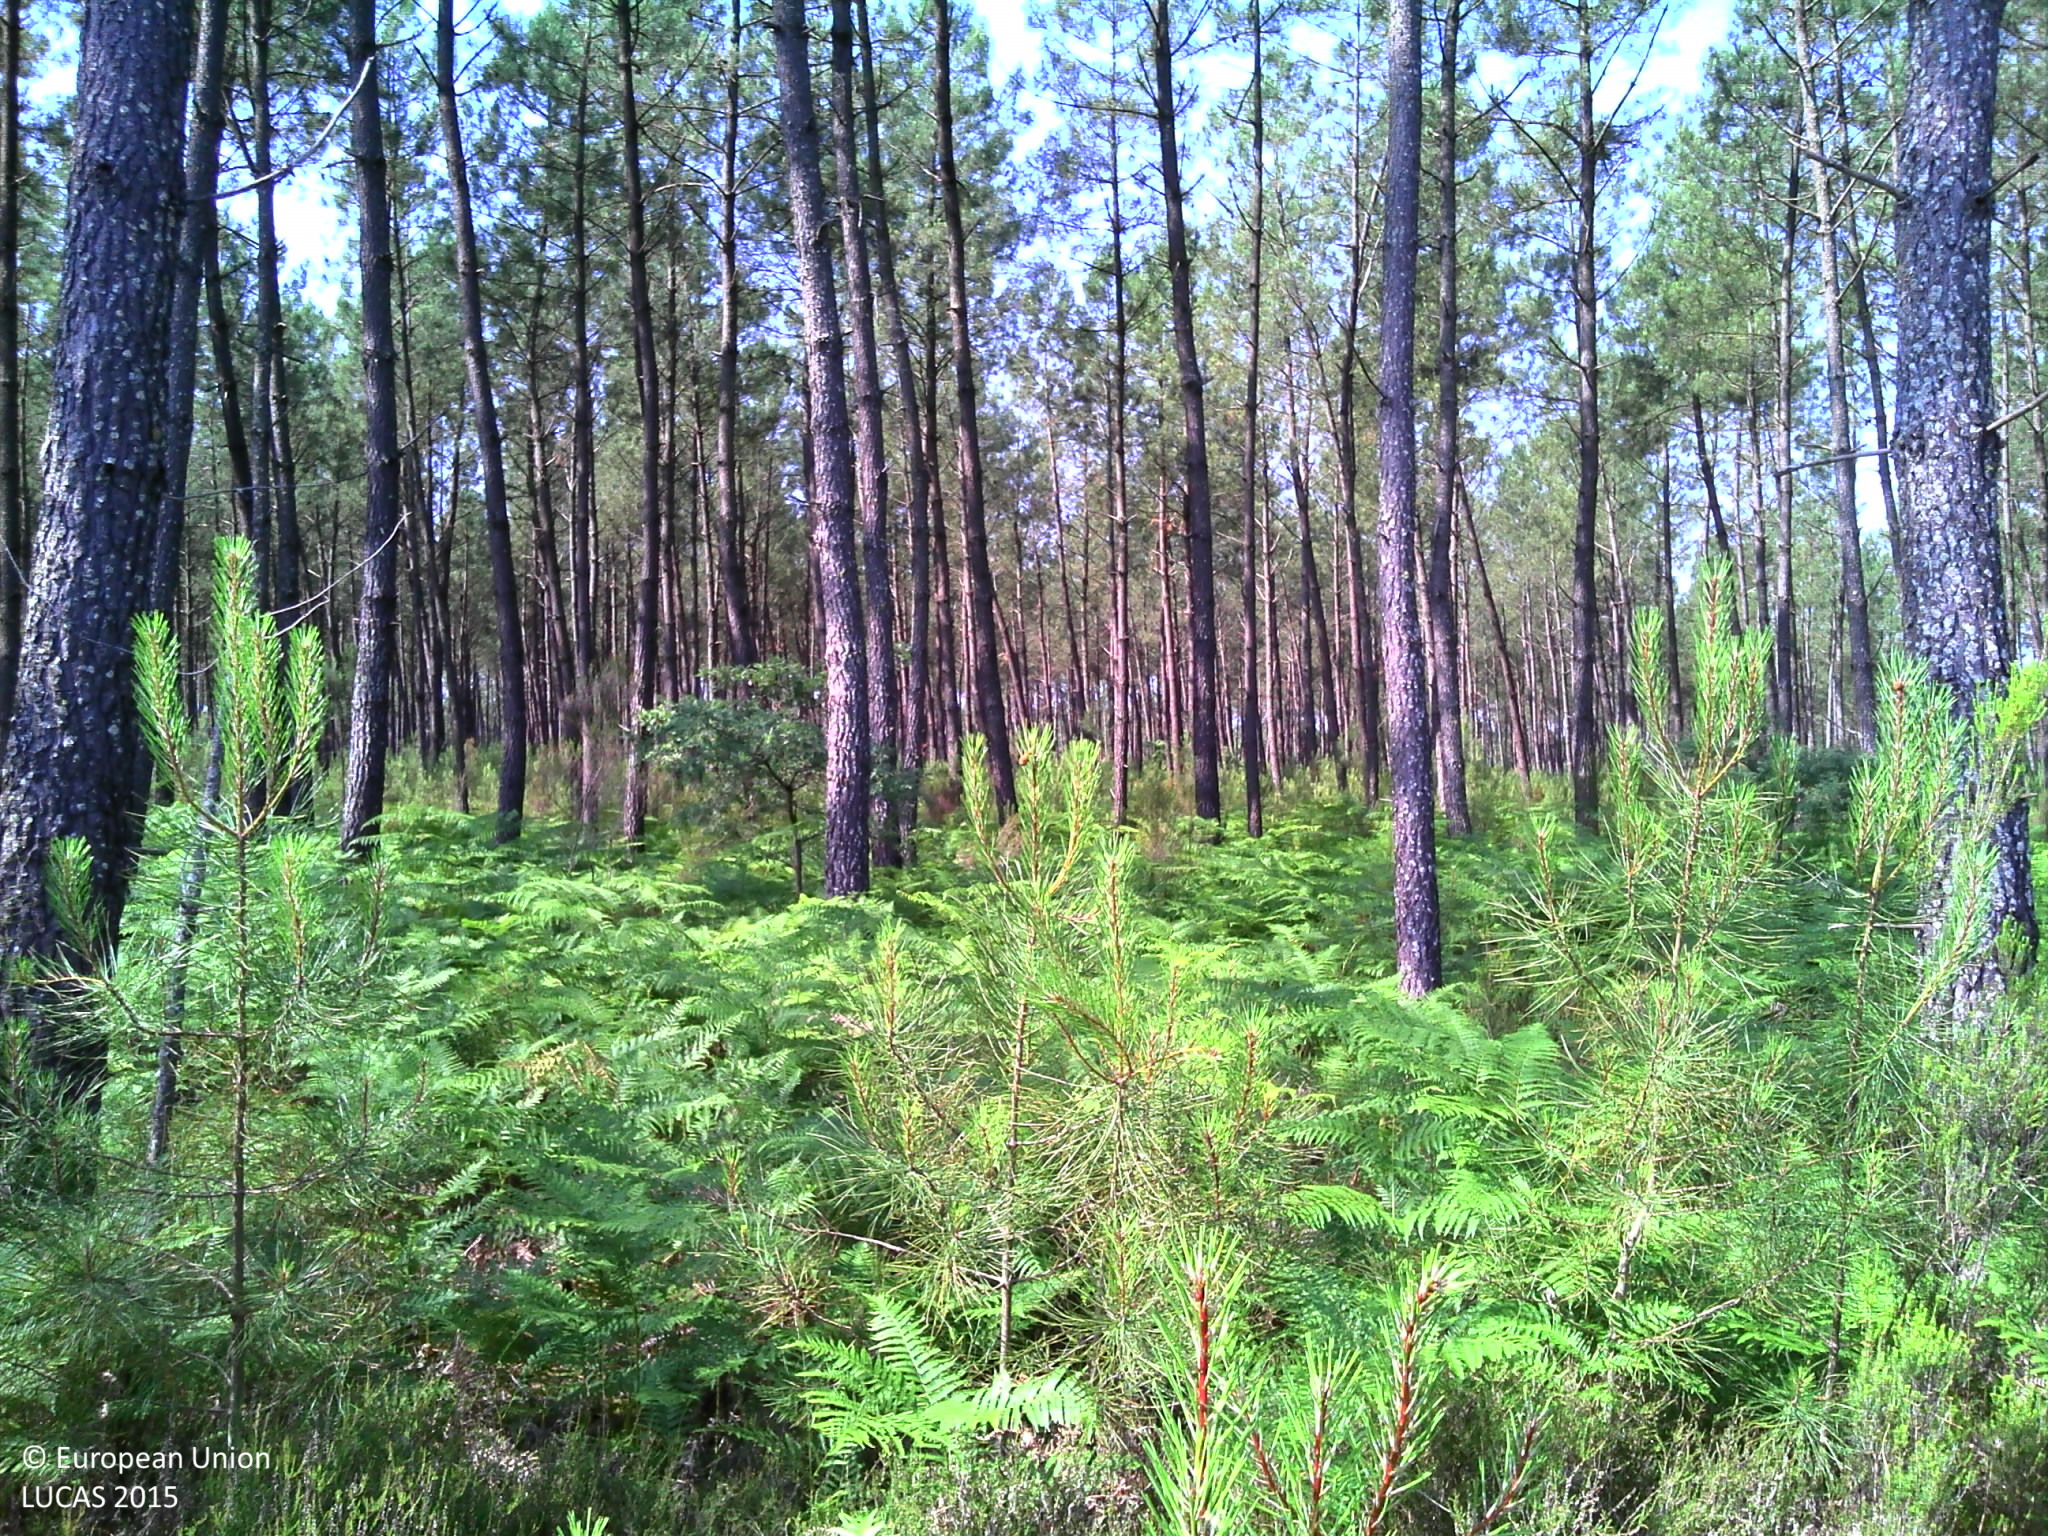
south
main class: Woodland
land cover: Pine dominated coniferous woodland
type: coniferous forest of the mediterranean region
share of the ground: > 75 %
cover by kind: coniferous forest trees 80 %, shrubs 15 %, herbaceous plants 5 %
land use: Forestry
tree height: > 5 m
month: June
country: FR
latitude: 44.0920
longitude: -0.2908
